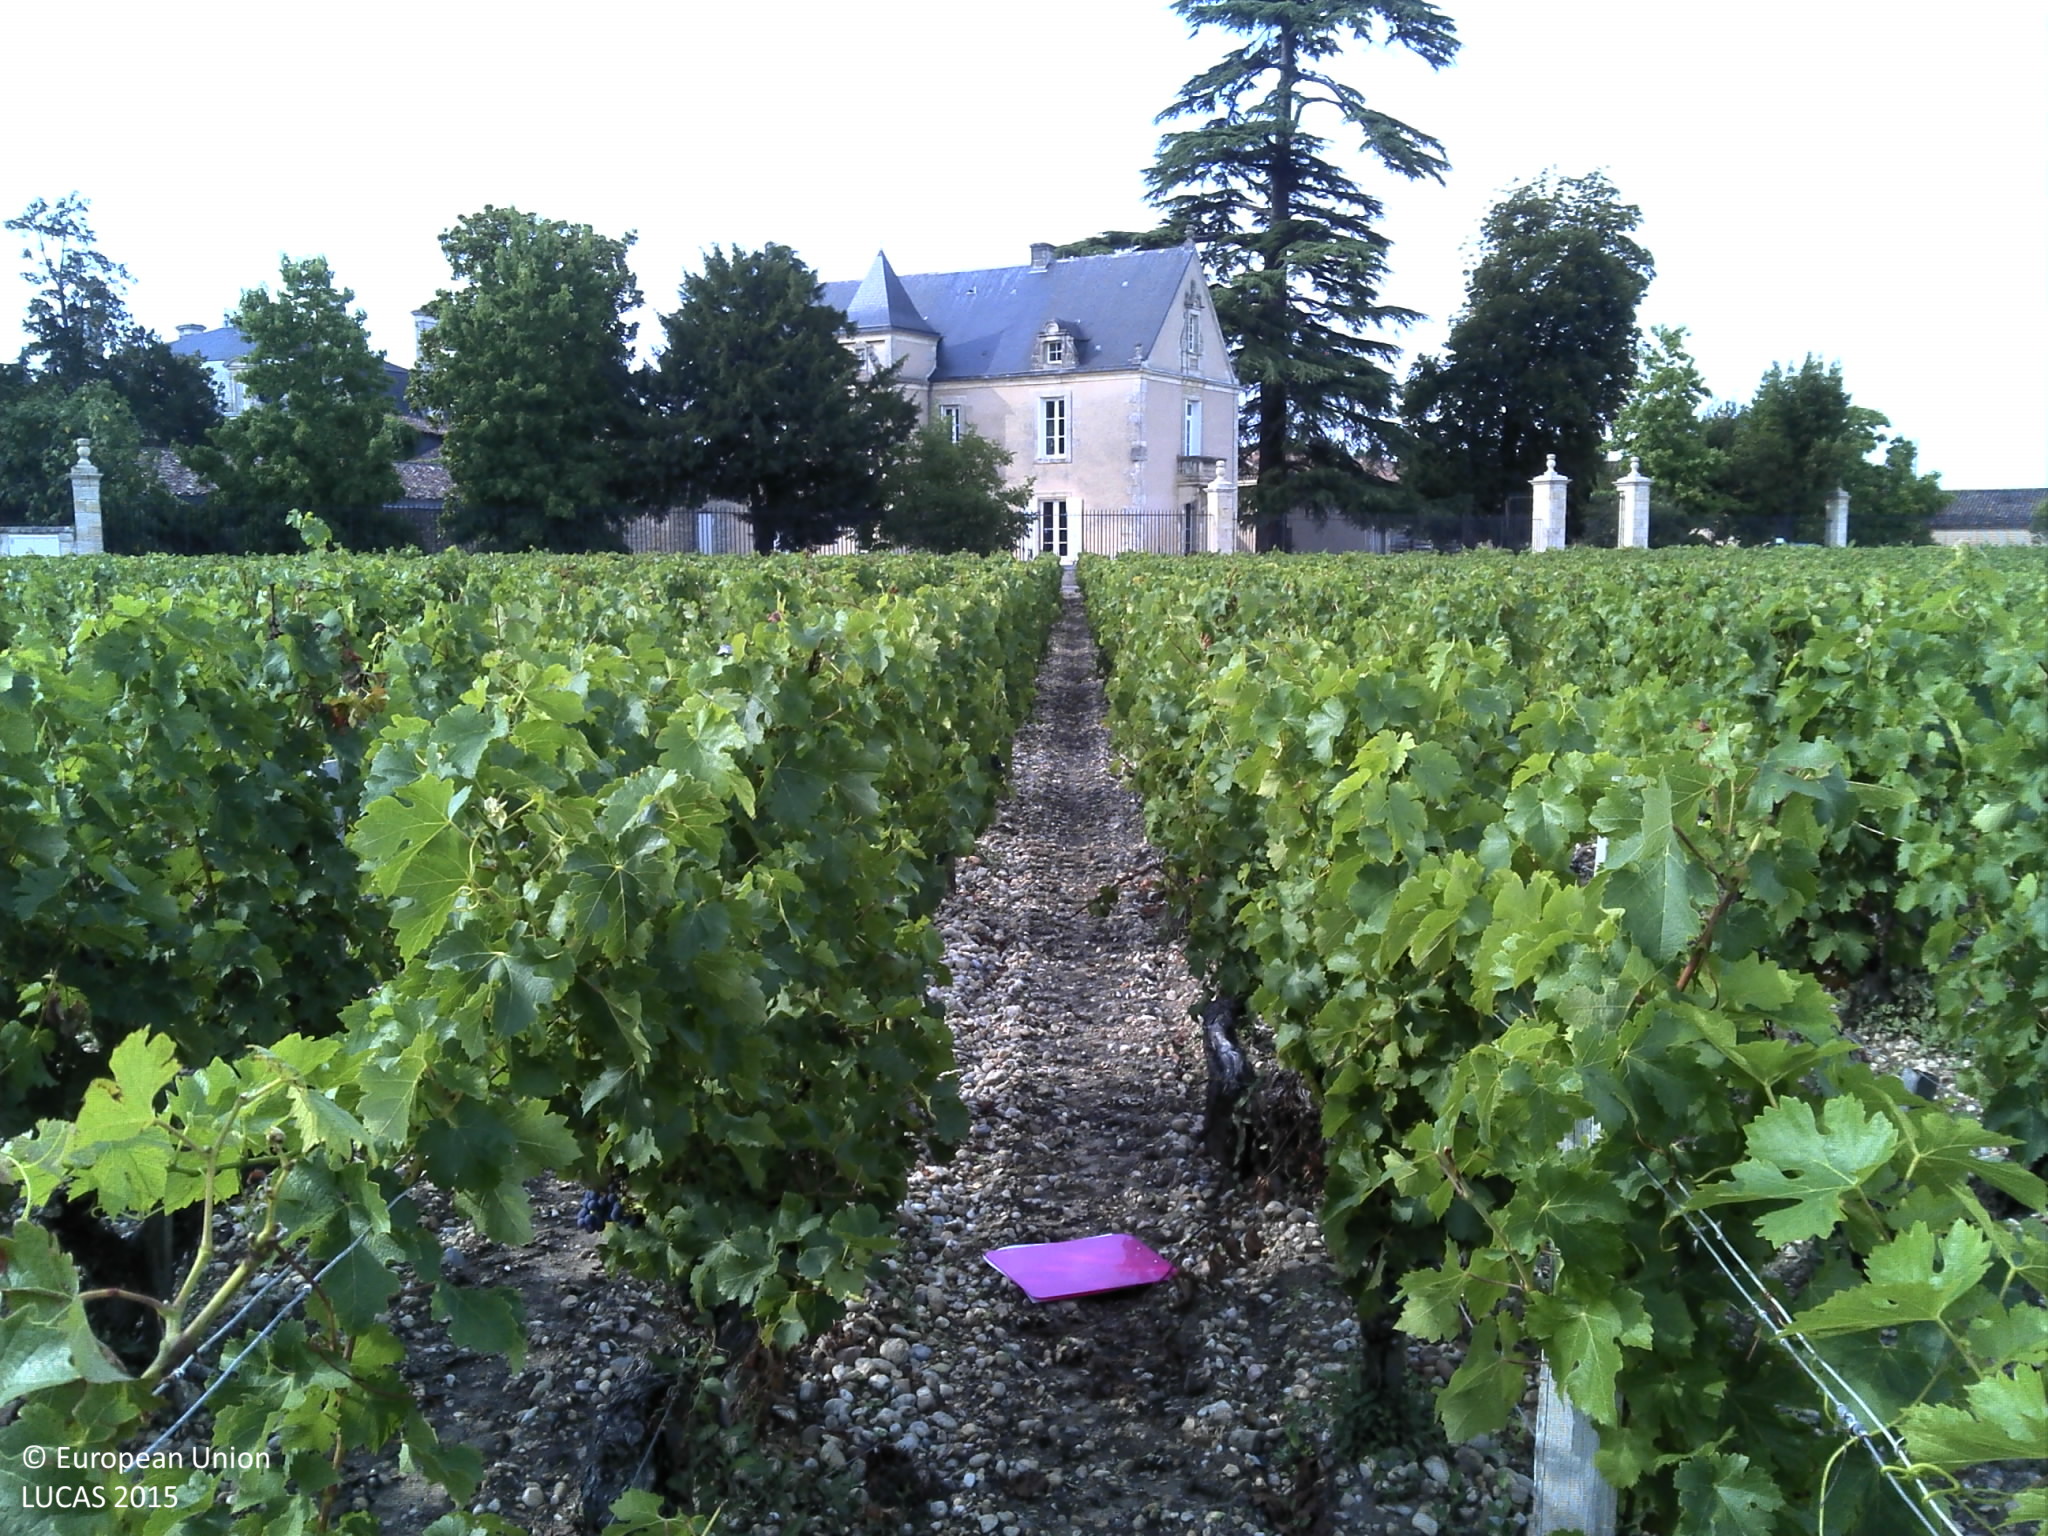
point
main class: Cropland
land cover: Vineyards
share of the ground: 25 - 50 %
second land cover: Other bare soil
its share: > 75 %
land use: Agriculture (excluding fallow land and kitchen gardens)
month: August
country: FR
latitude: 45.2408
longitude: -0.7877
